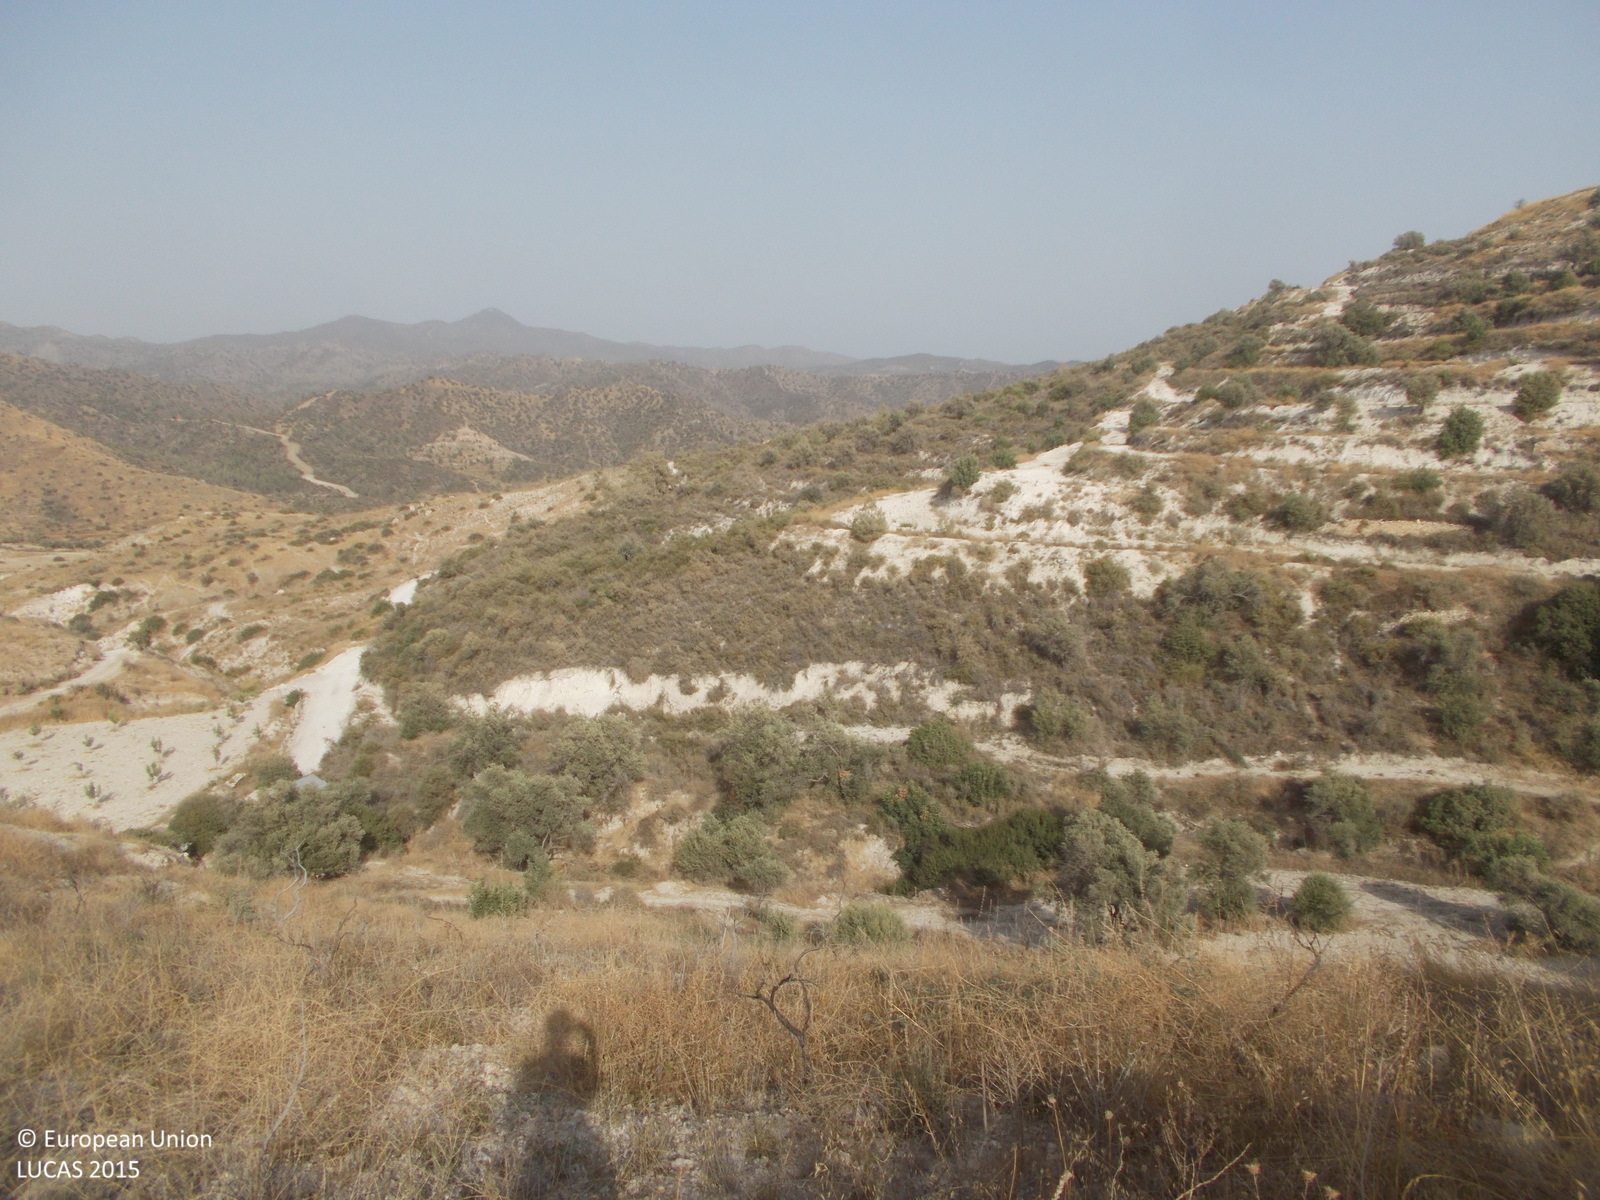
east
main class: Shrubland
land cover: Shrubland without tree cover
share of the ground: 50 - 75 %
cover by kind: shrubs 55 %, herbaceous plants 30 %, unconsolidated bare surface 15 %
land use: Semi-natural and natural areas not in use
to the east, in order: Shrubland without tree cover; Shrubland with sparse tree cover; Olive groves; Tracks; Olive groves; Shrubland with sparse tree cover; Shrubland without tree cover; Shrubland with sparse tree cover
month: April
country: CY
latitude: 34.8571
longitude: 33.3377
